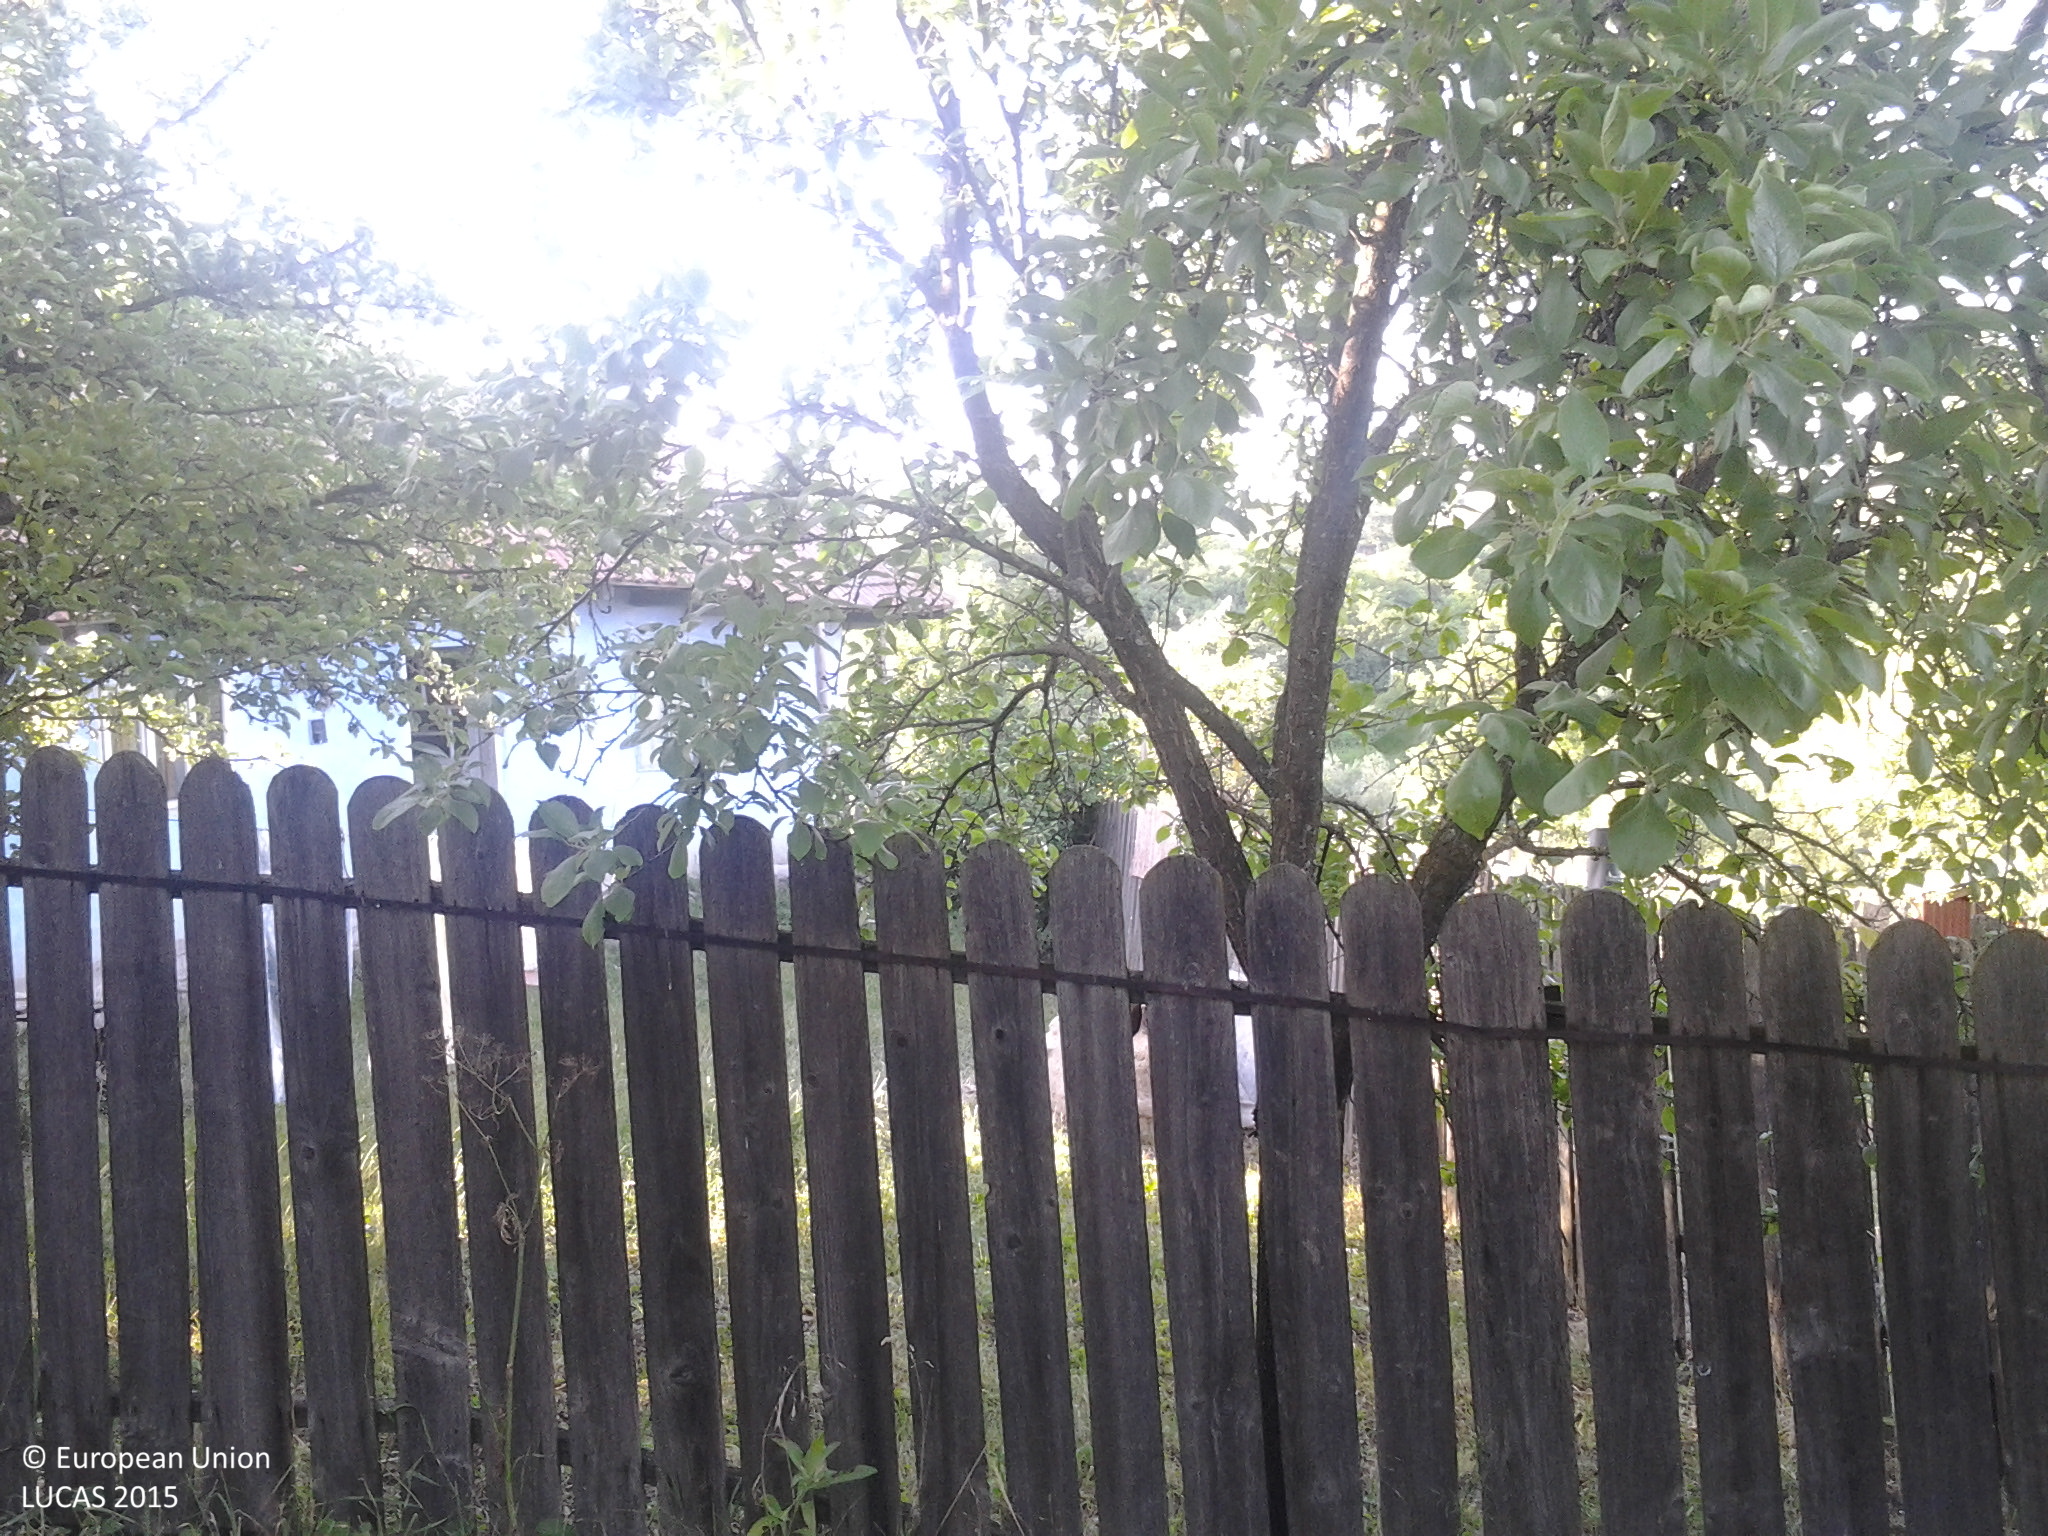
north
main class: Grassland
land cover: Grassland with sparse tree/shrub cover
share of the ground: > 75 %
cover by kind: herbaceous plants 90 %, broadleaved forest trees 5 %, shrubs 5 %
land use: Agriculture (excluding fallow land and kitchen gardens)
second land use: Residential
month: June
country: RO
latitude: 47.1998
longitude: 26.9022
